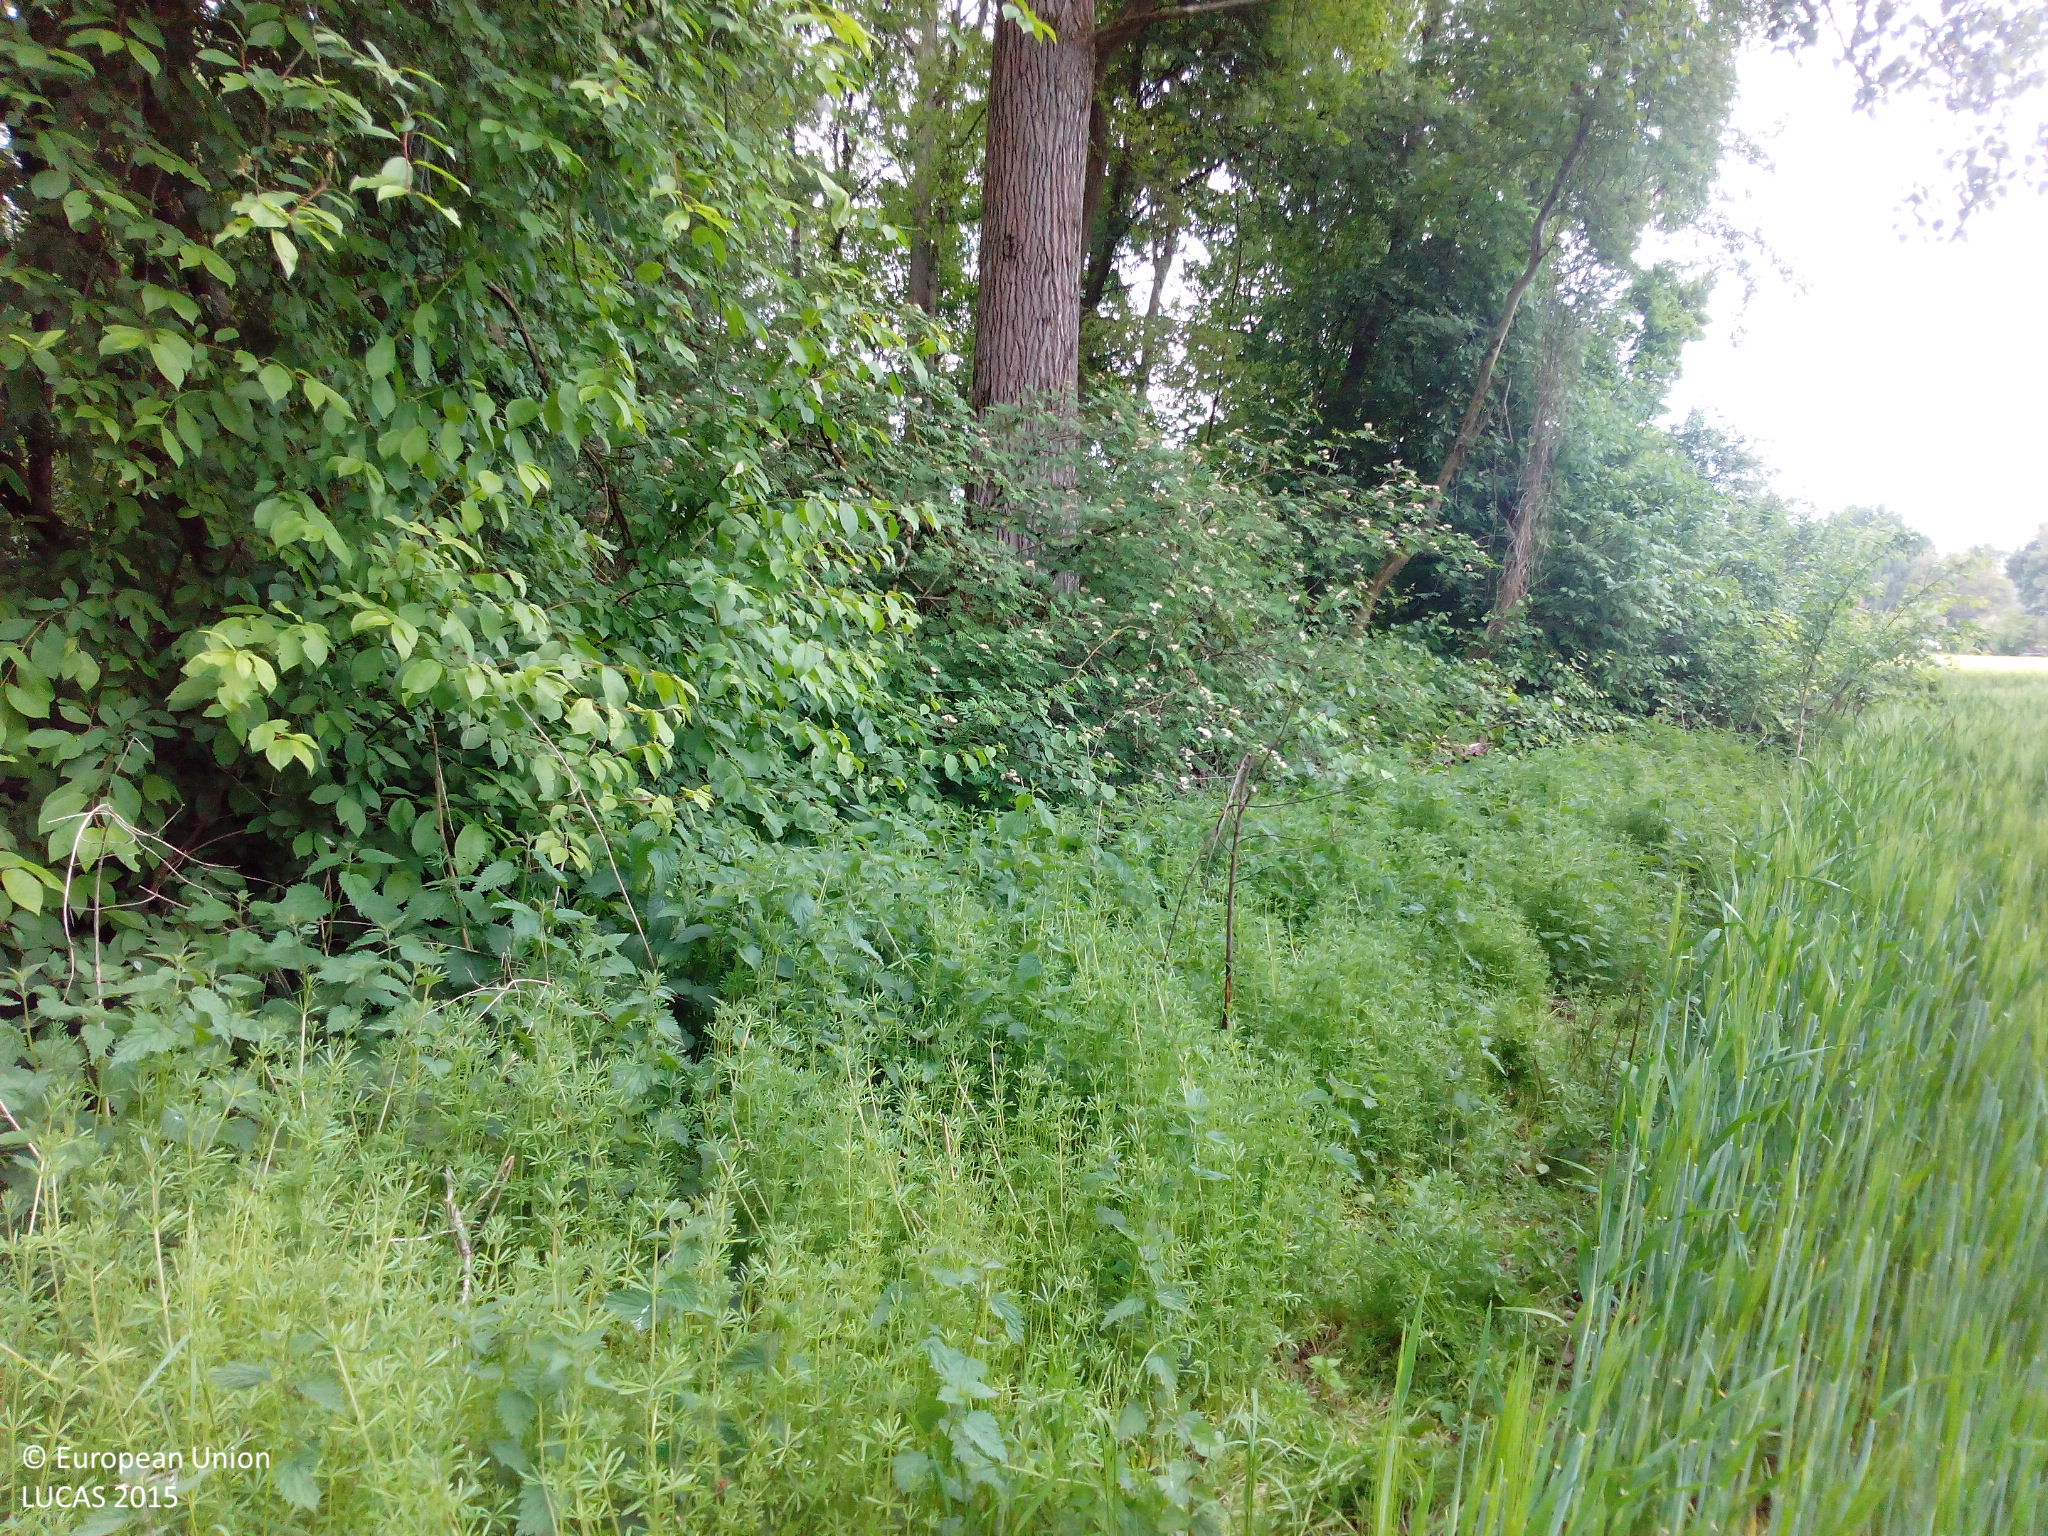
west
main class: Cropland
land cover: Barley
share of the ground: > 75 %
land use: Agriculture (excluding fallow land and kitchen gardens)
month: May
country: DE
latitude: 52.0191
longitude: 8.0040
